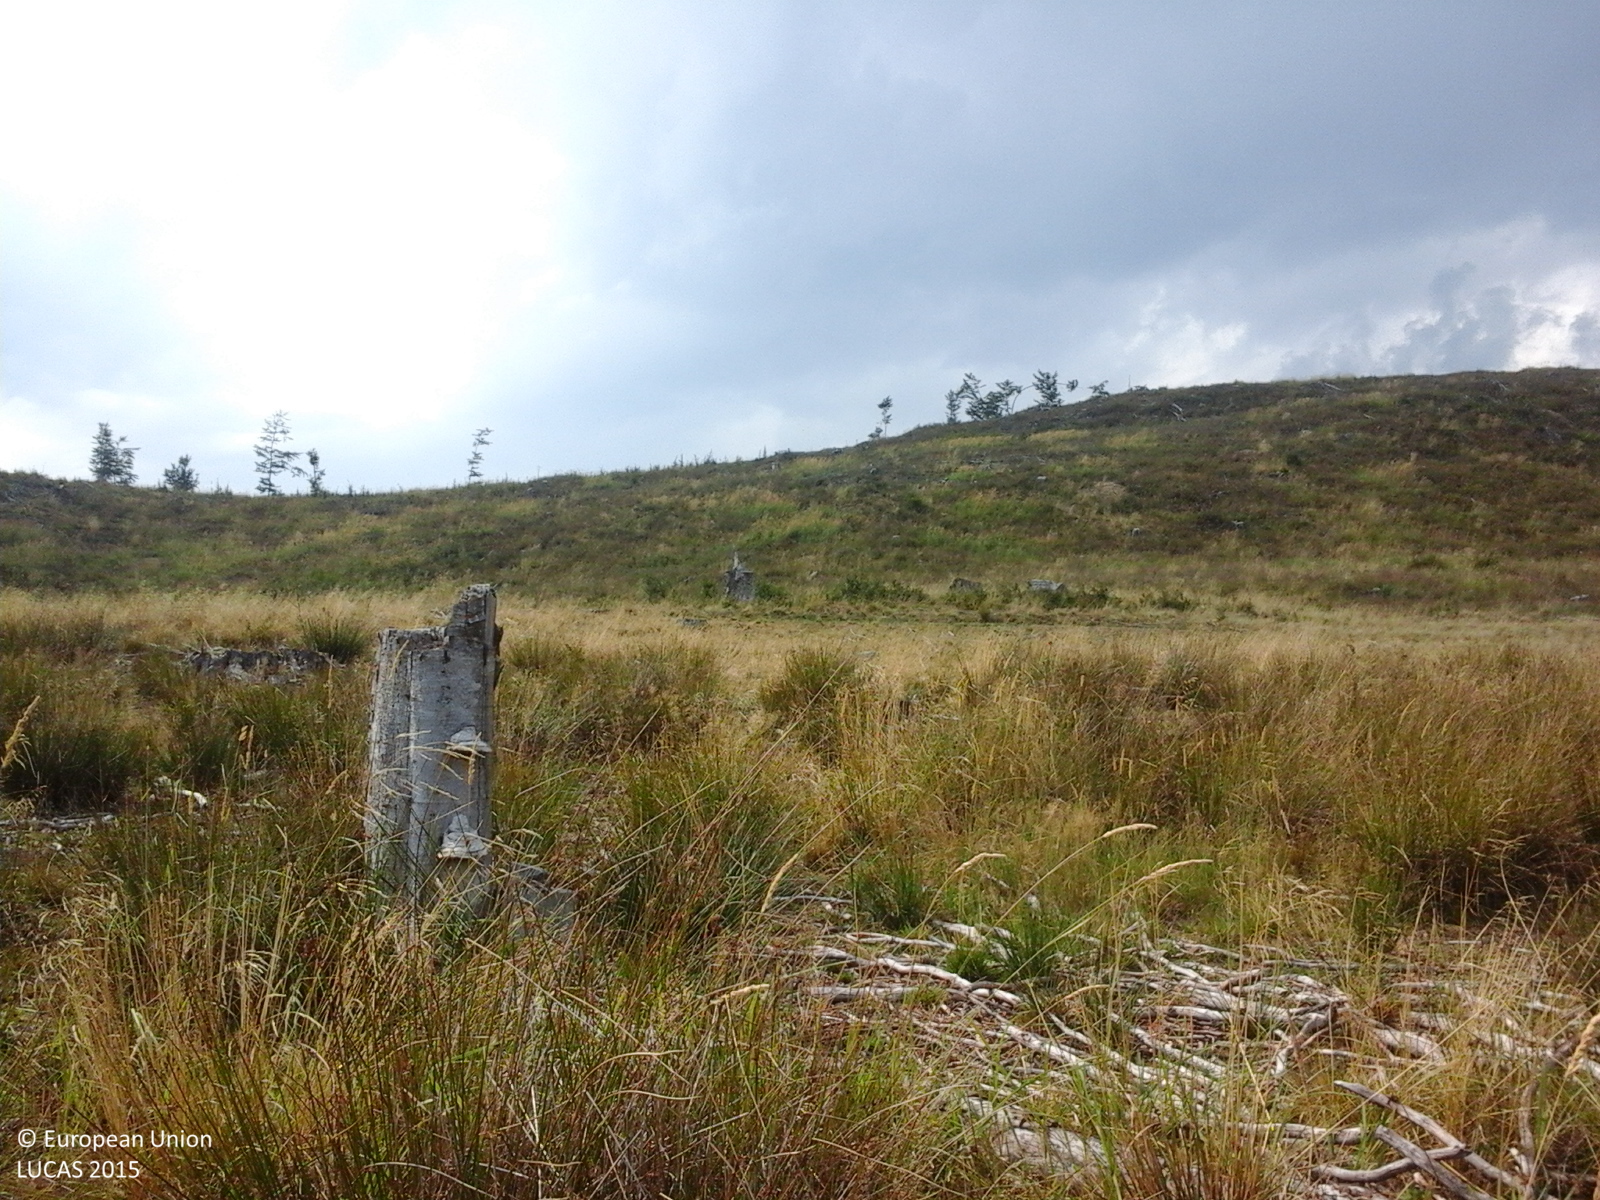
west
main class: Grassland
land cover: Spontaneously vegetated surfaces
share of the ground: > 75 %
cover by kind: herbaceous plants 100 %
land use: Forestry
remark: Clear cut
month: September
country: RO
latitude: 47.8561
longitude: 23.6990
